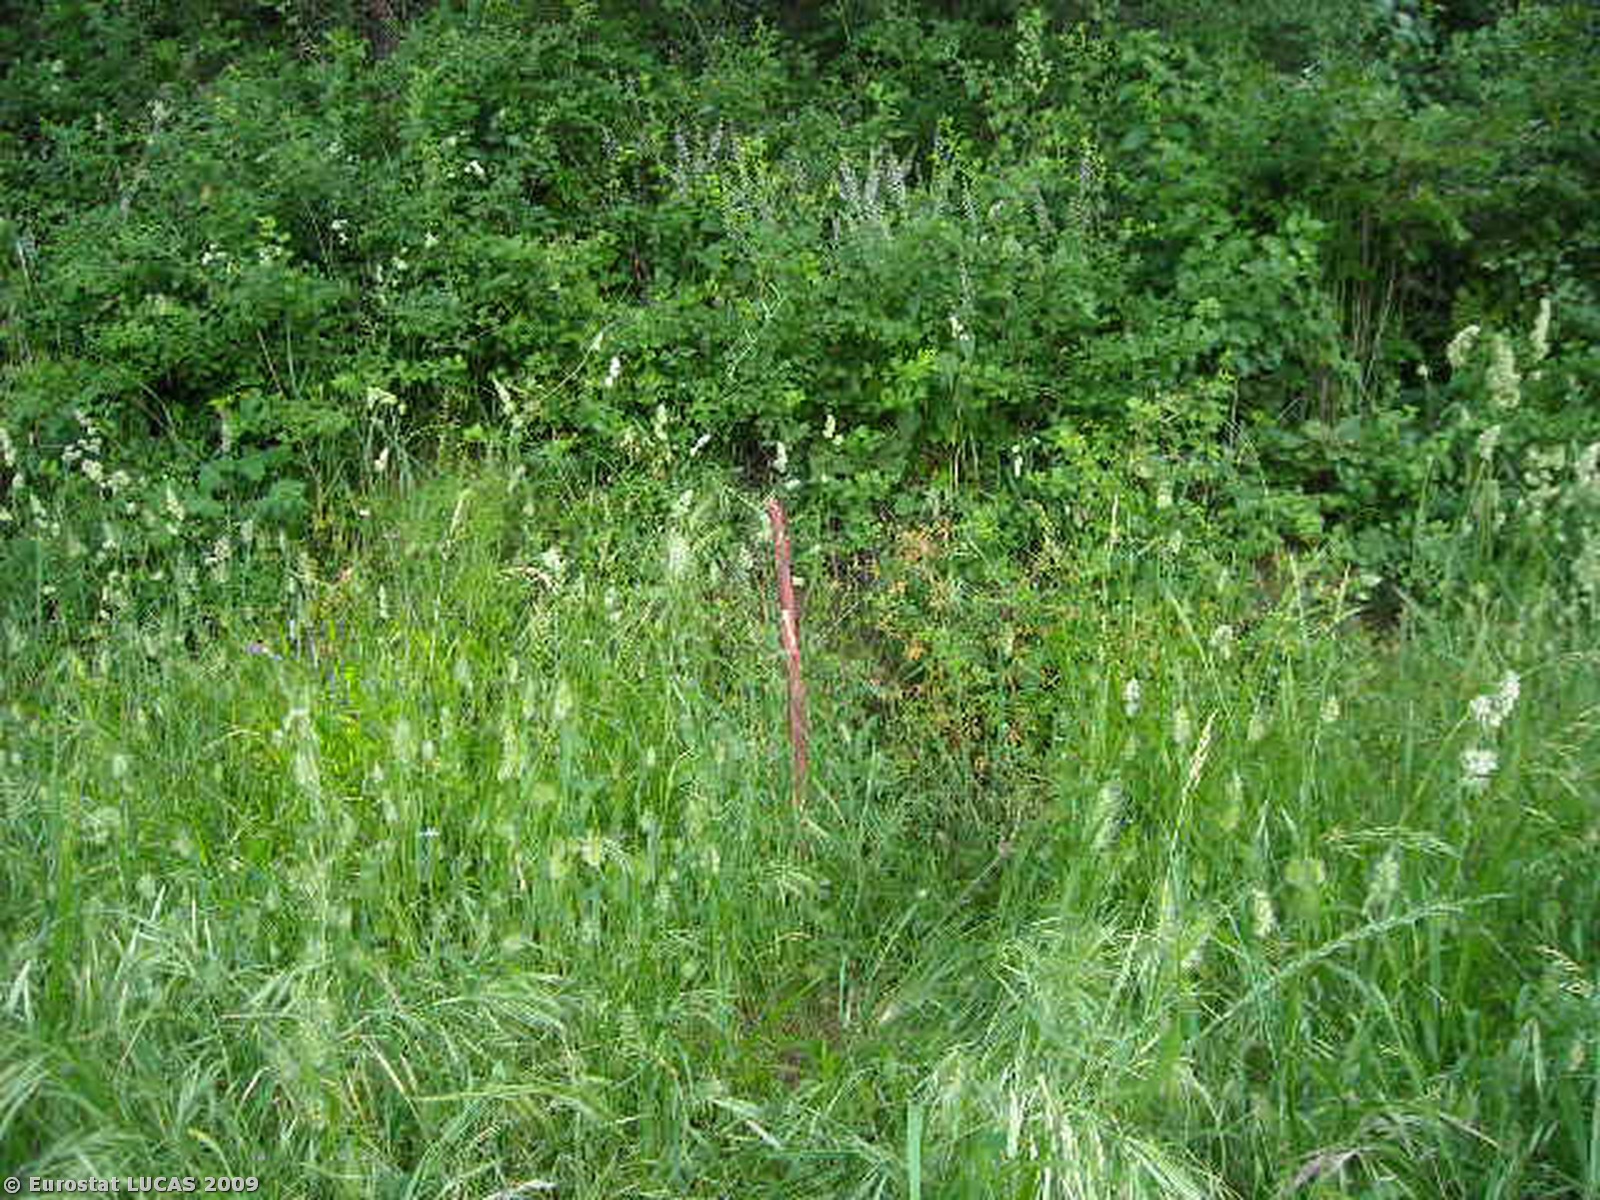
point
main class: Woodland
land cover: Broadleaved woodland
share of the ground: > 75 %
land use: Agriculture (excluding fallow land and kitchen gardens)
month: May
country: IT
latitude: 40.5730
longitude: 16.2964
